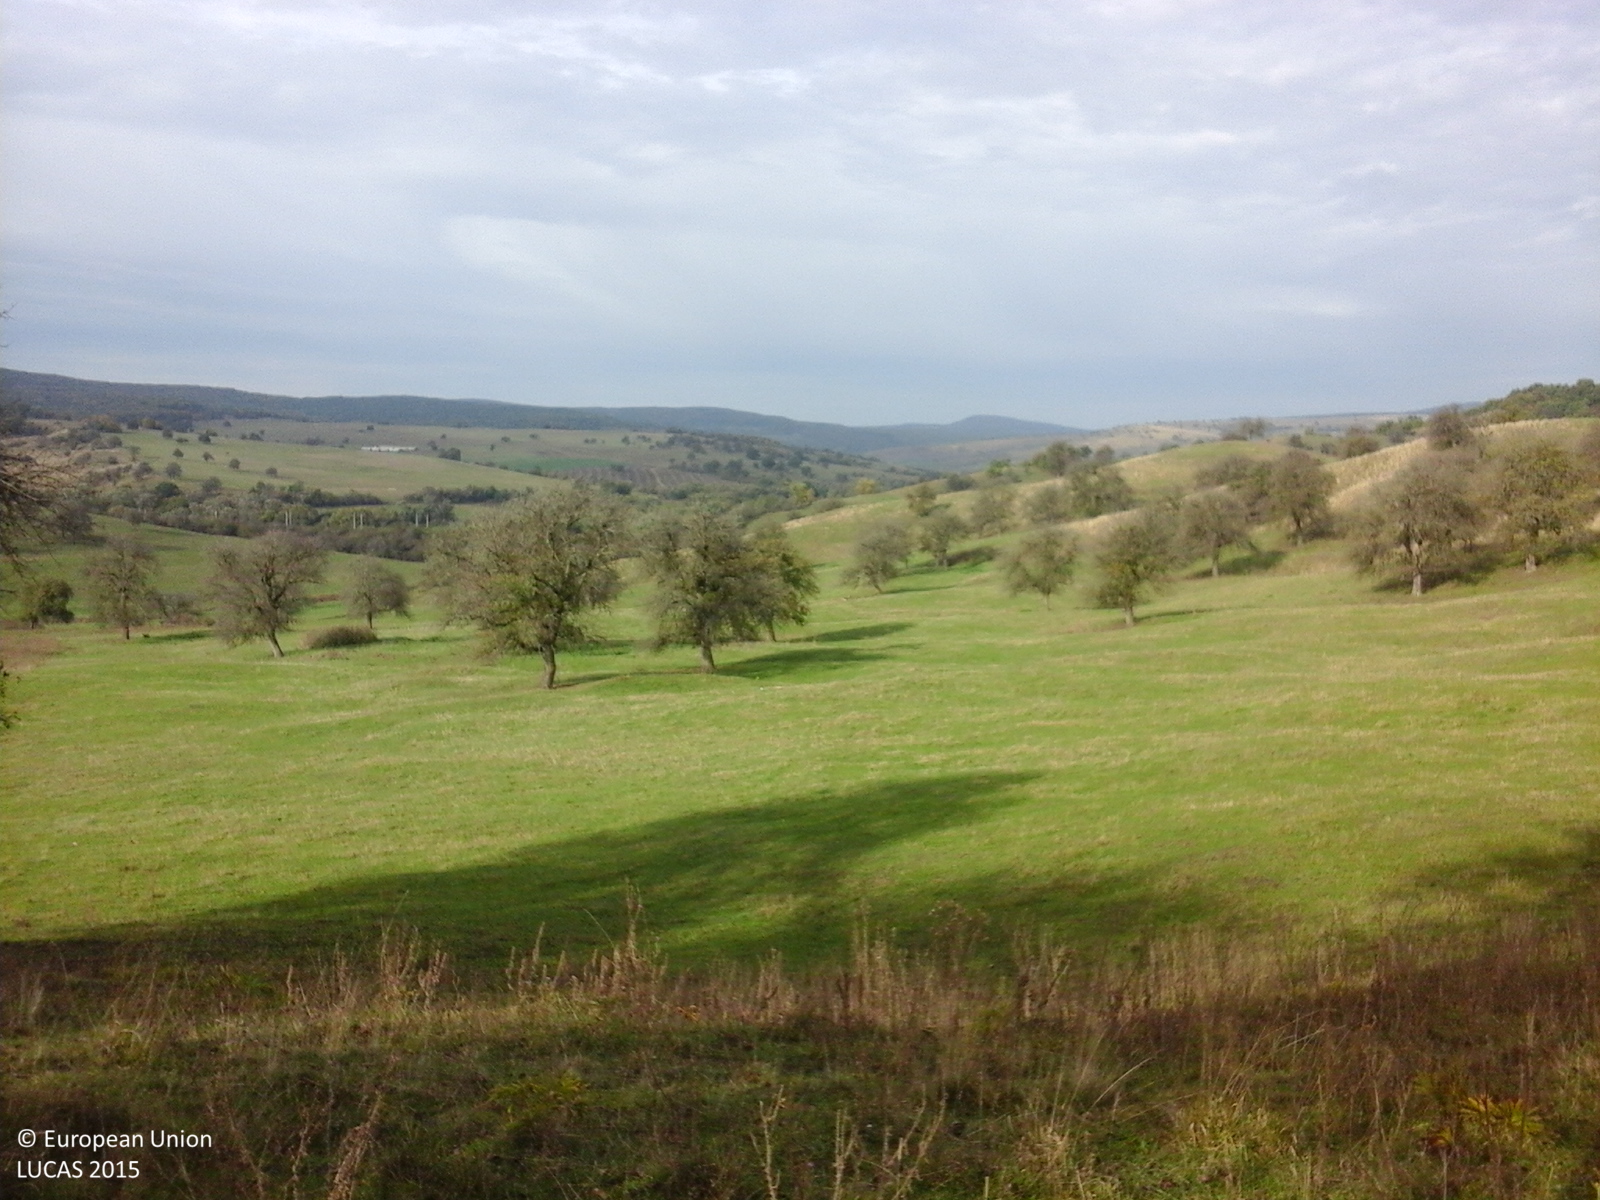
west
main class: Cropland
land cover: Pear fruit
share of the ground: > 75 %
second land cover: Grassland without tree/shrub cover
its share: > 75 %
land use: Agriculture (excluding fallow land and kitchen gardens)
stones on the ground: < 10 %
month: October
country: RO
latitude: 46.1779
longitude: 25.1642
